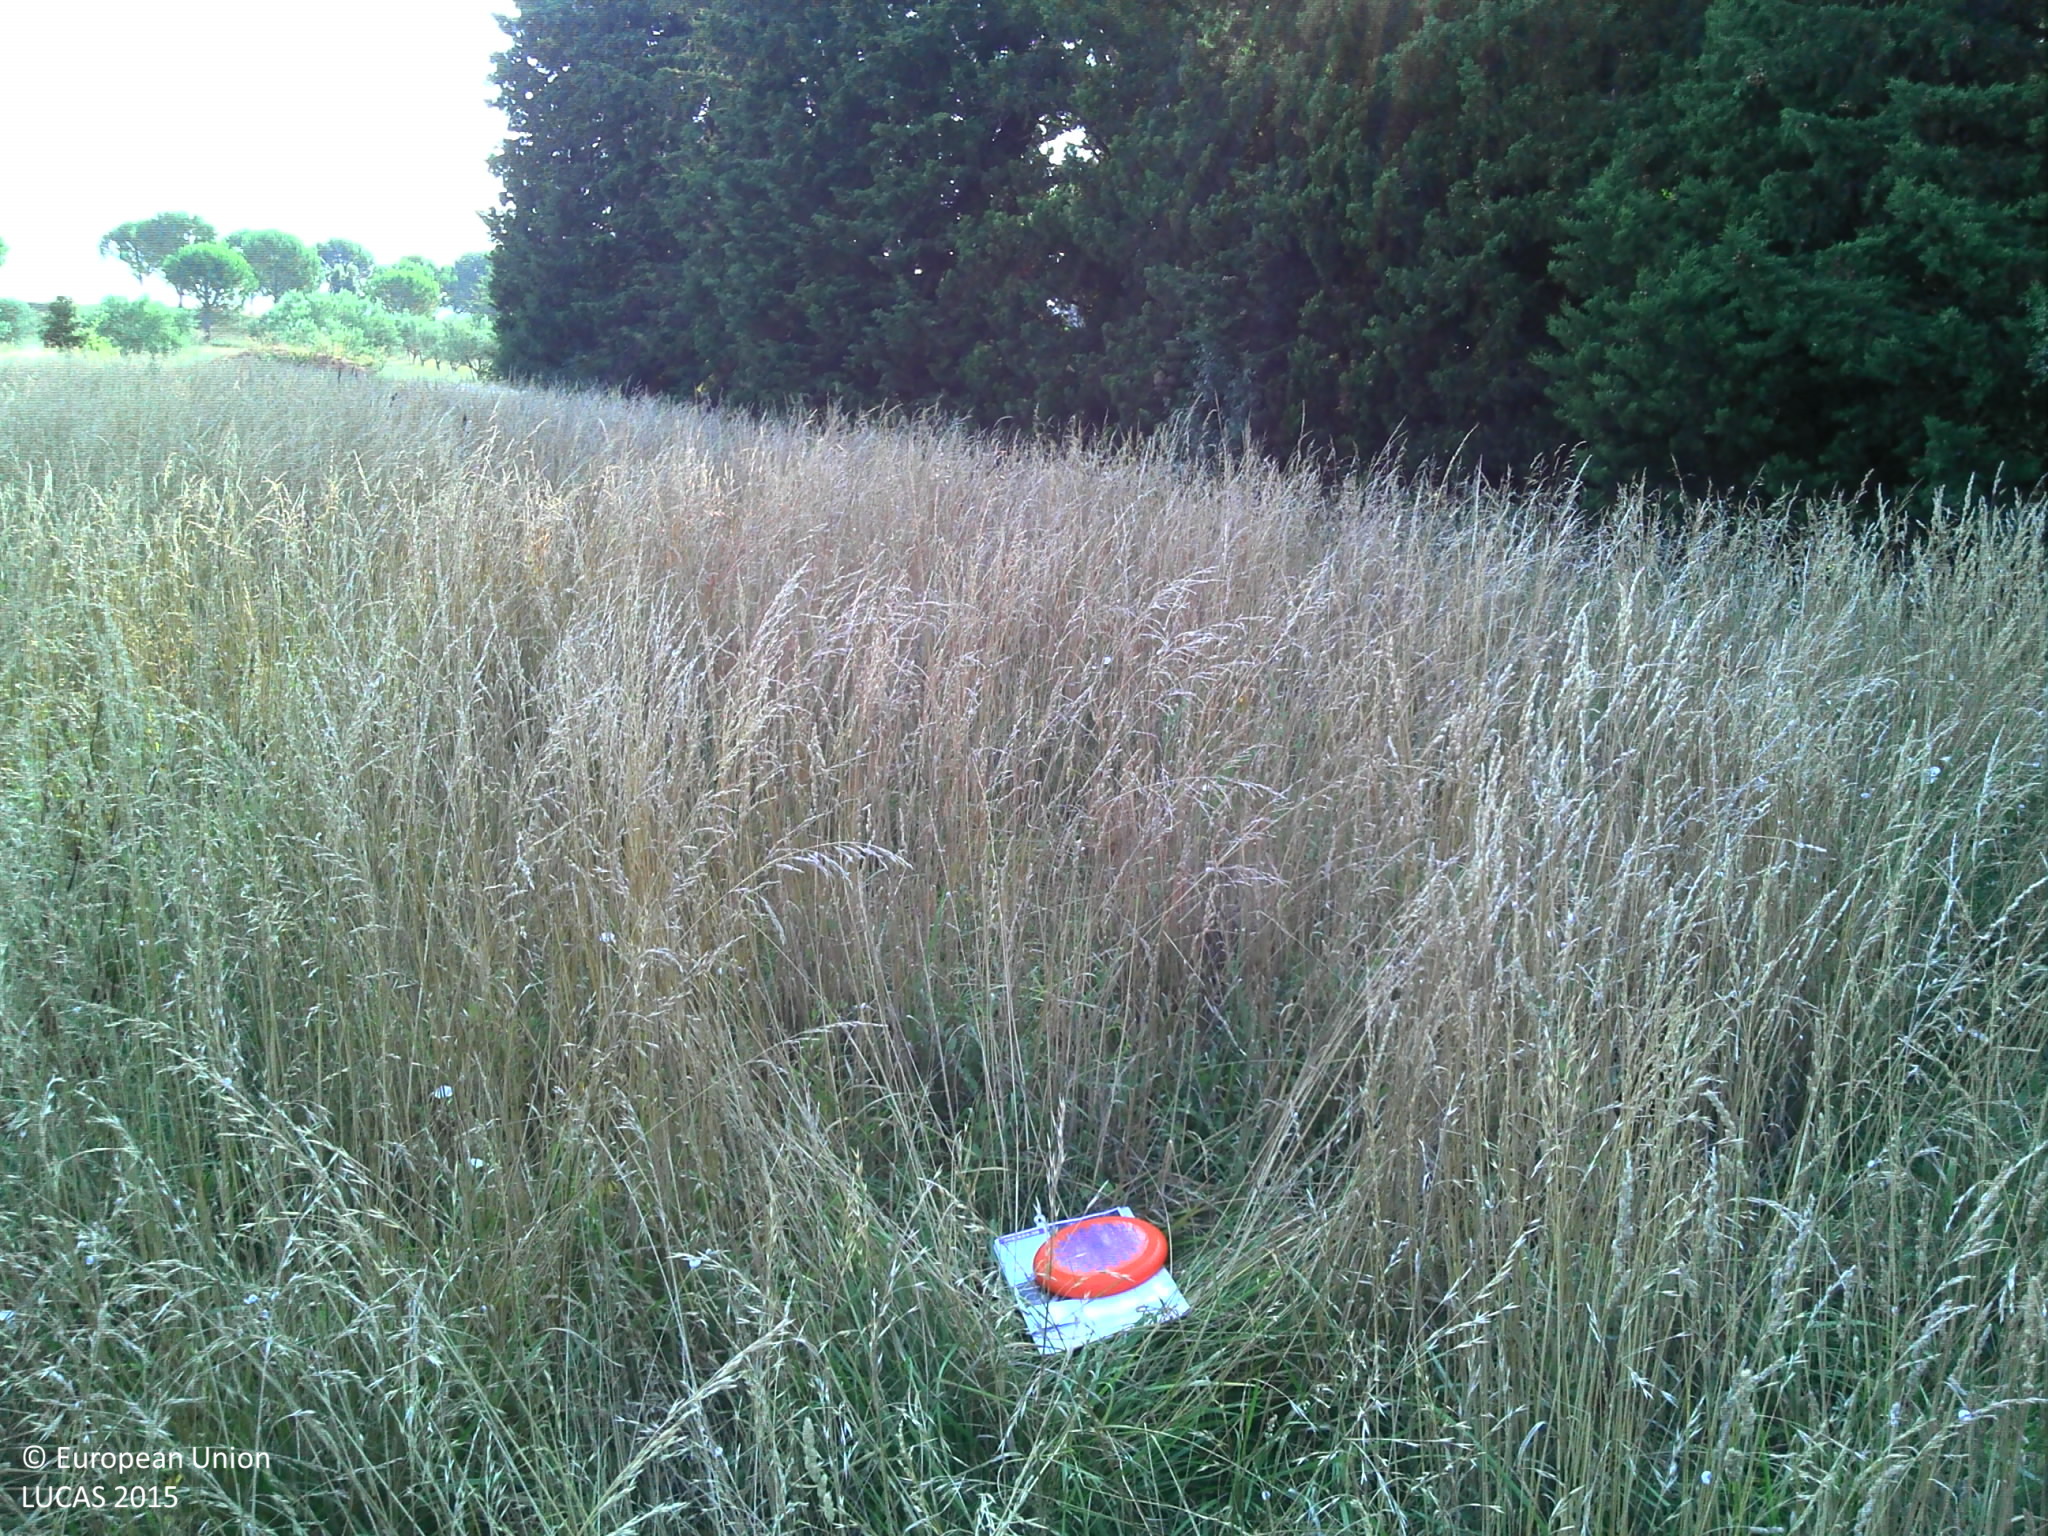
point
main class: Grassland
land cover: Grassland without tree/shrub cover
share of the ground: > 75 %
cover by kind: herbaceous plants 100 %
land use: Agriculture (excluding fallow land and kitchen gardens)
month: July
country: FR
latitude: 43.9607
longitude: 5.0359
